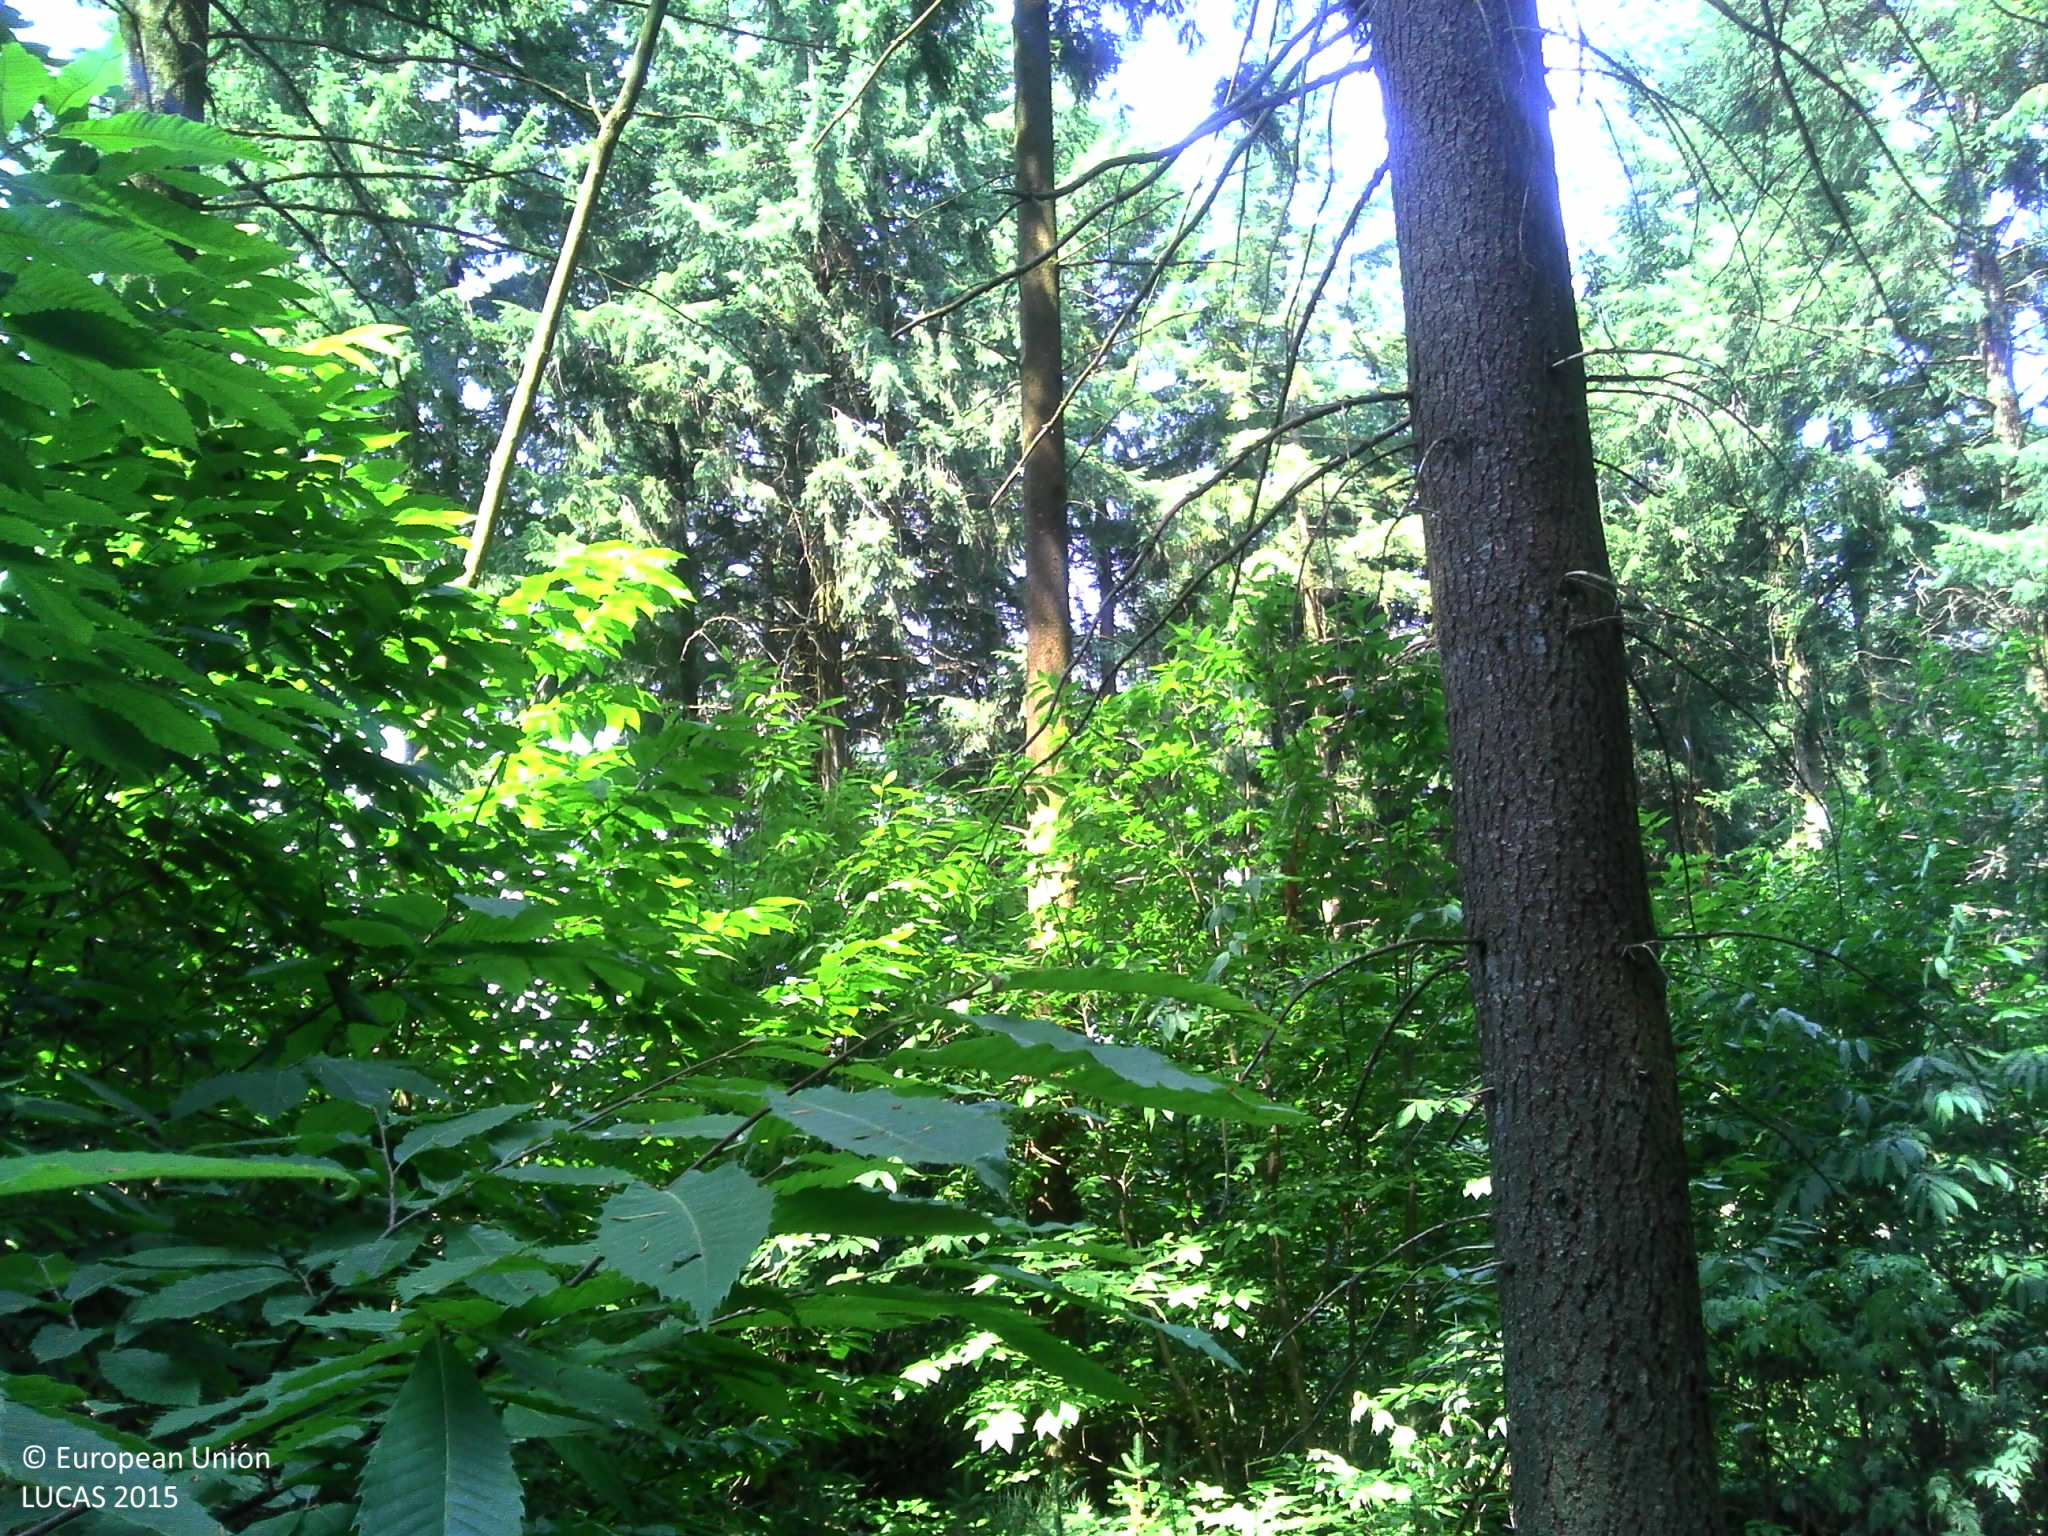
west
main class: Woodland
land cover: Spruce dominated coniferous woodland
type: exotic forest
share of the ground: > 75 %
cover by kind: coniferous forest trees 60 %, broadleaved forest trees 15 %, shrubs 10 %, lichens and mosses 10 %, herbaceous plants 5 %
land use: Forestry
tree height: > 5 m
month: July
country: FR
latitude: 45.9616
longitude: 1.7738
